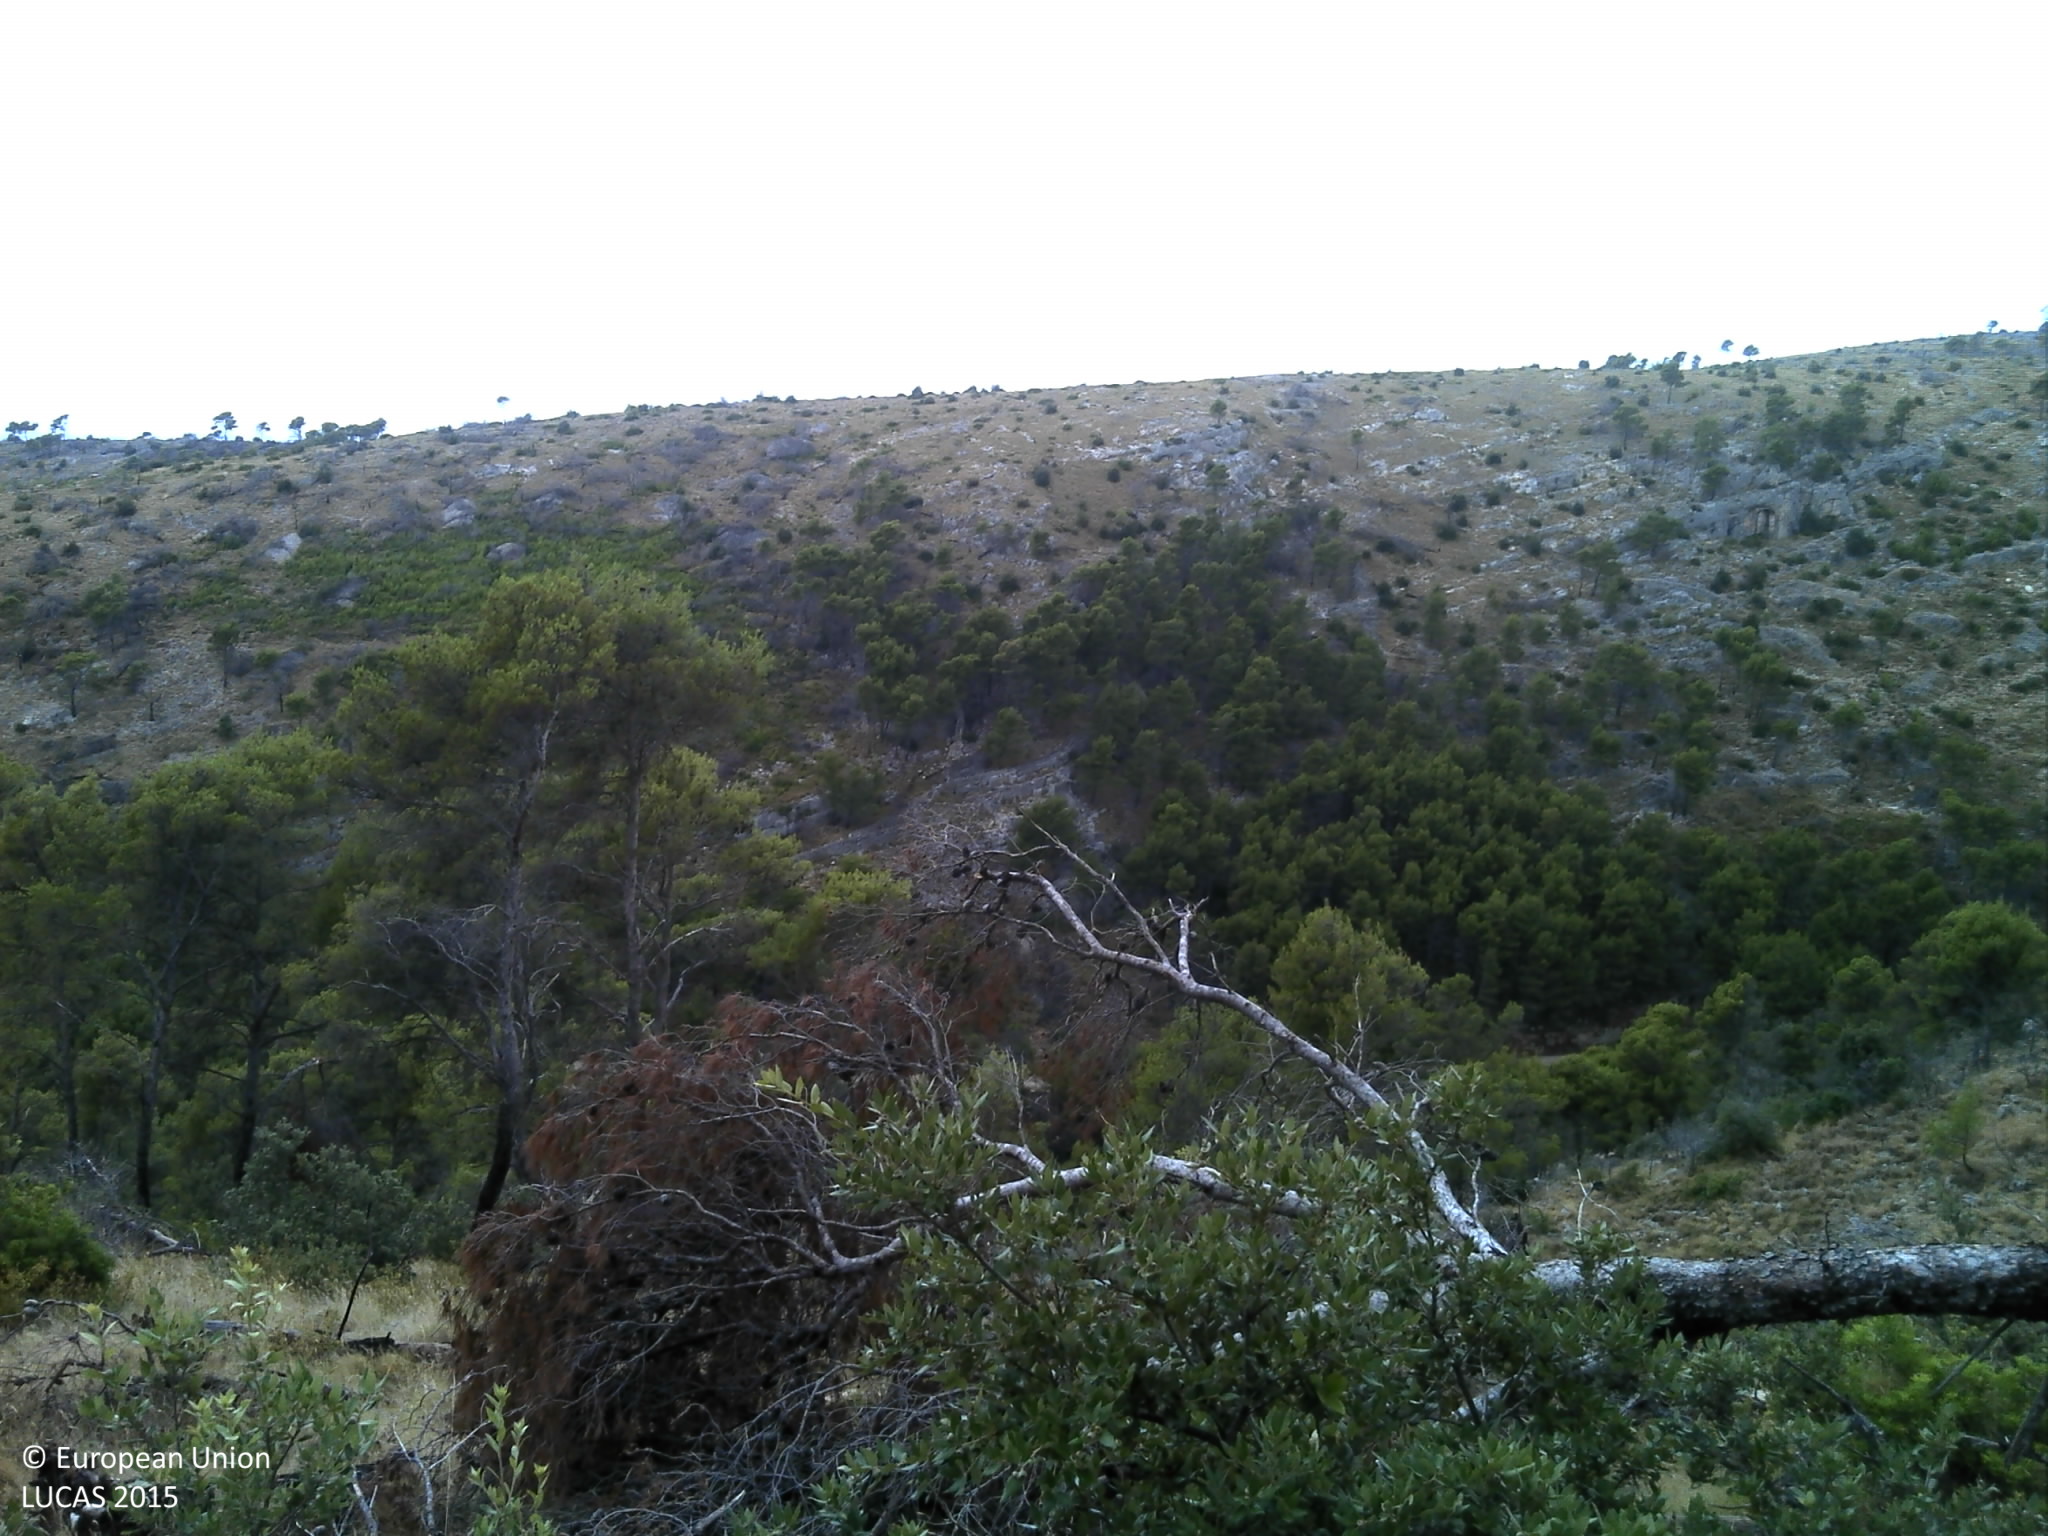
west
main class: Woodland
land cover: Pine dominated coniferous woodland
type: coniferous forest of the mediterranean region
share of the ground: 50 - 75 %
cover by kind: coniferous forest trees 50 %, shrubs 20 %, unconsolidated bare surface 15 %, herbaceous plants 10 %, consolidated bare surface 5 %
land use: Semi-natural and natural areas not in use
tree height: > 5 m
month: July
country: HR
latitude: 43.2971
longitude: 16.4859
